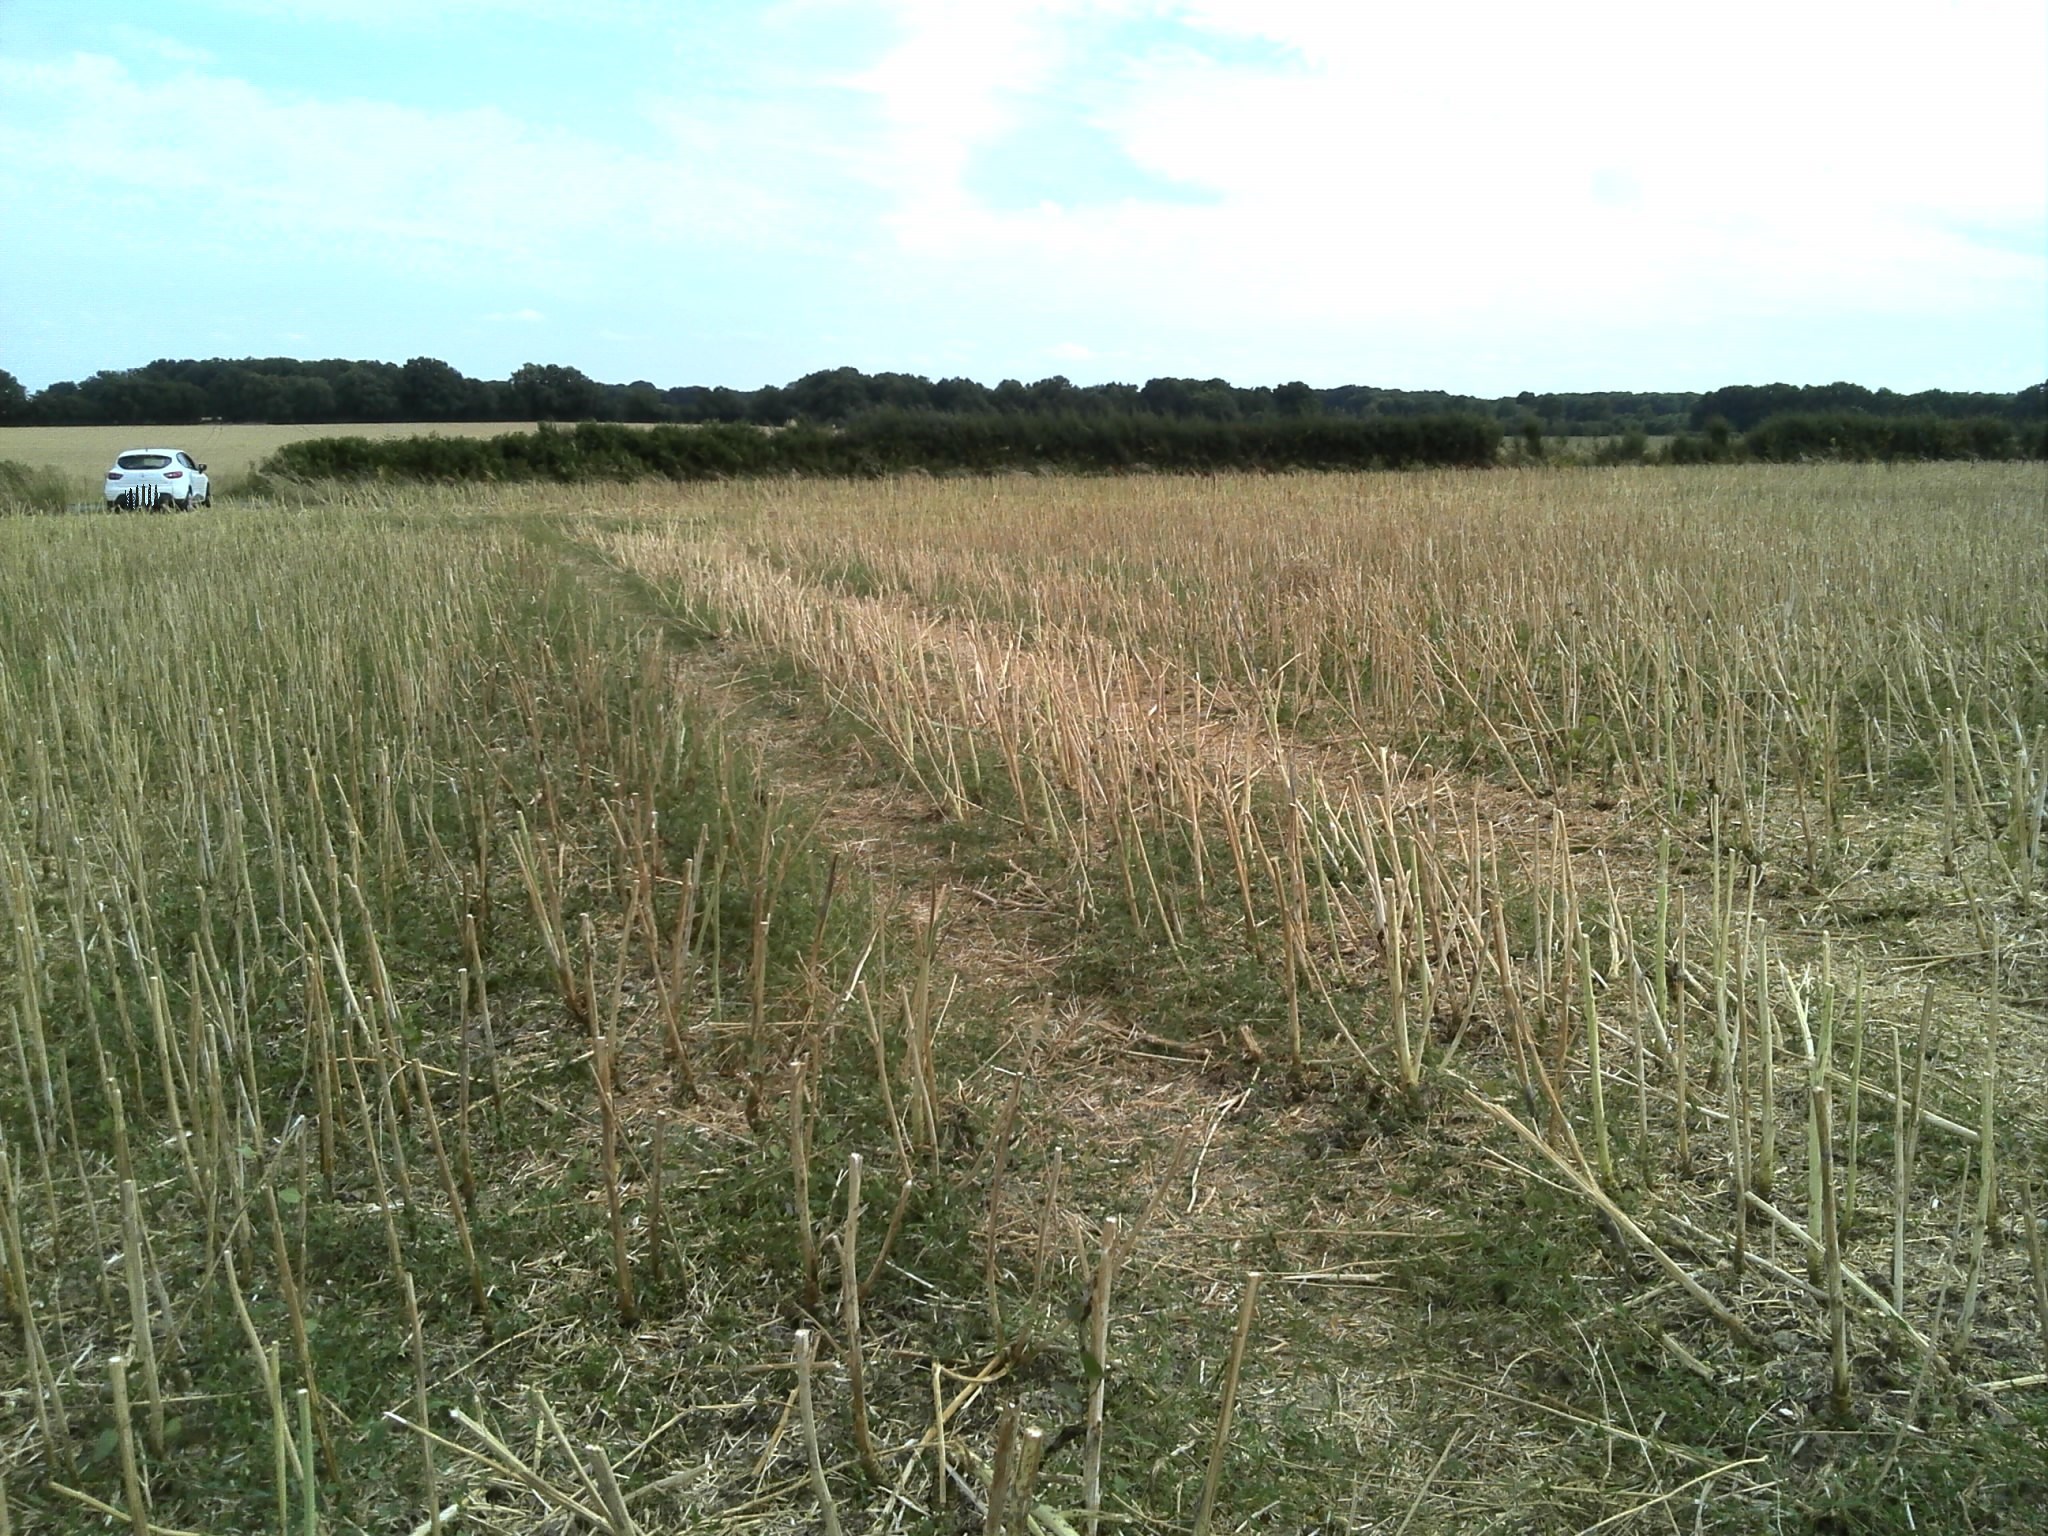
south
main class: Cropland
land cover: Rape and turnip rape
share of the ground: < 10 %
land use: Agriculture (excluding fallow land and kitchen gardens)
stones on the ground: < 10 %
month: July
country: FR
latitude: 46.6984
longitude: 1.4751
